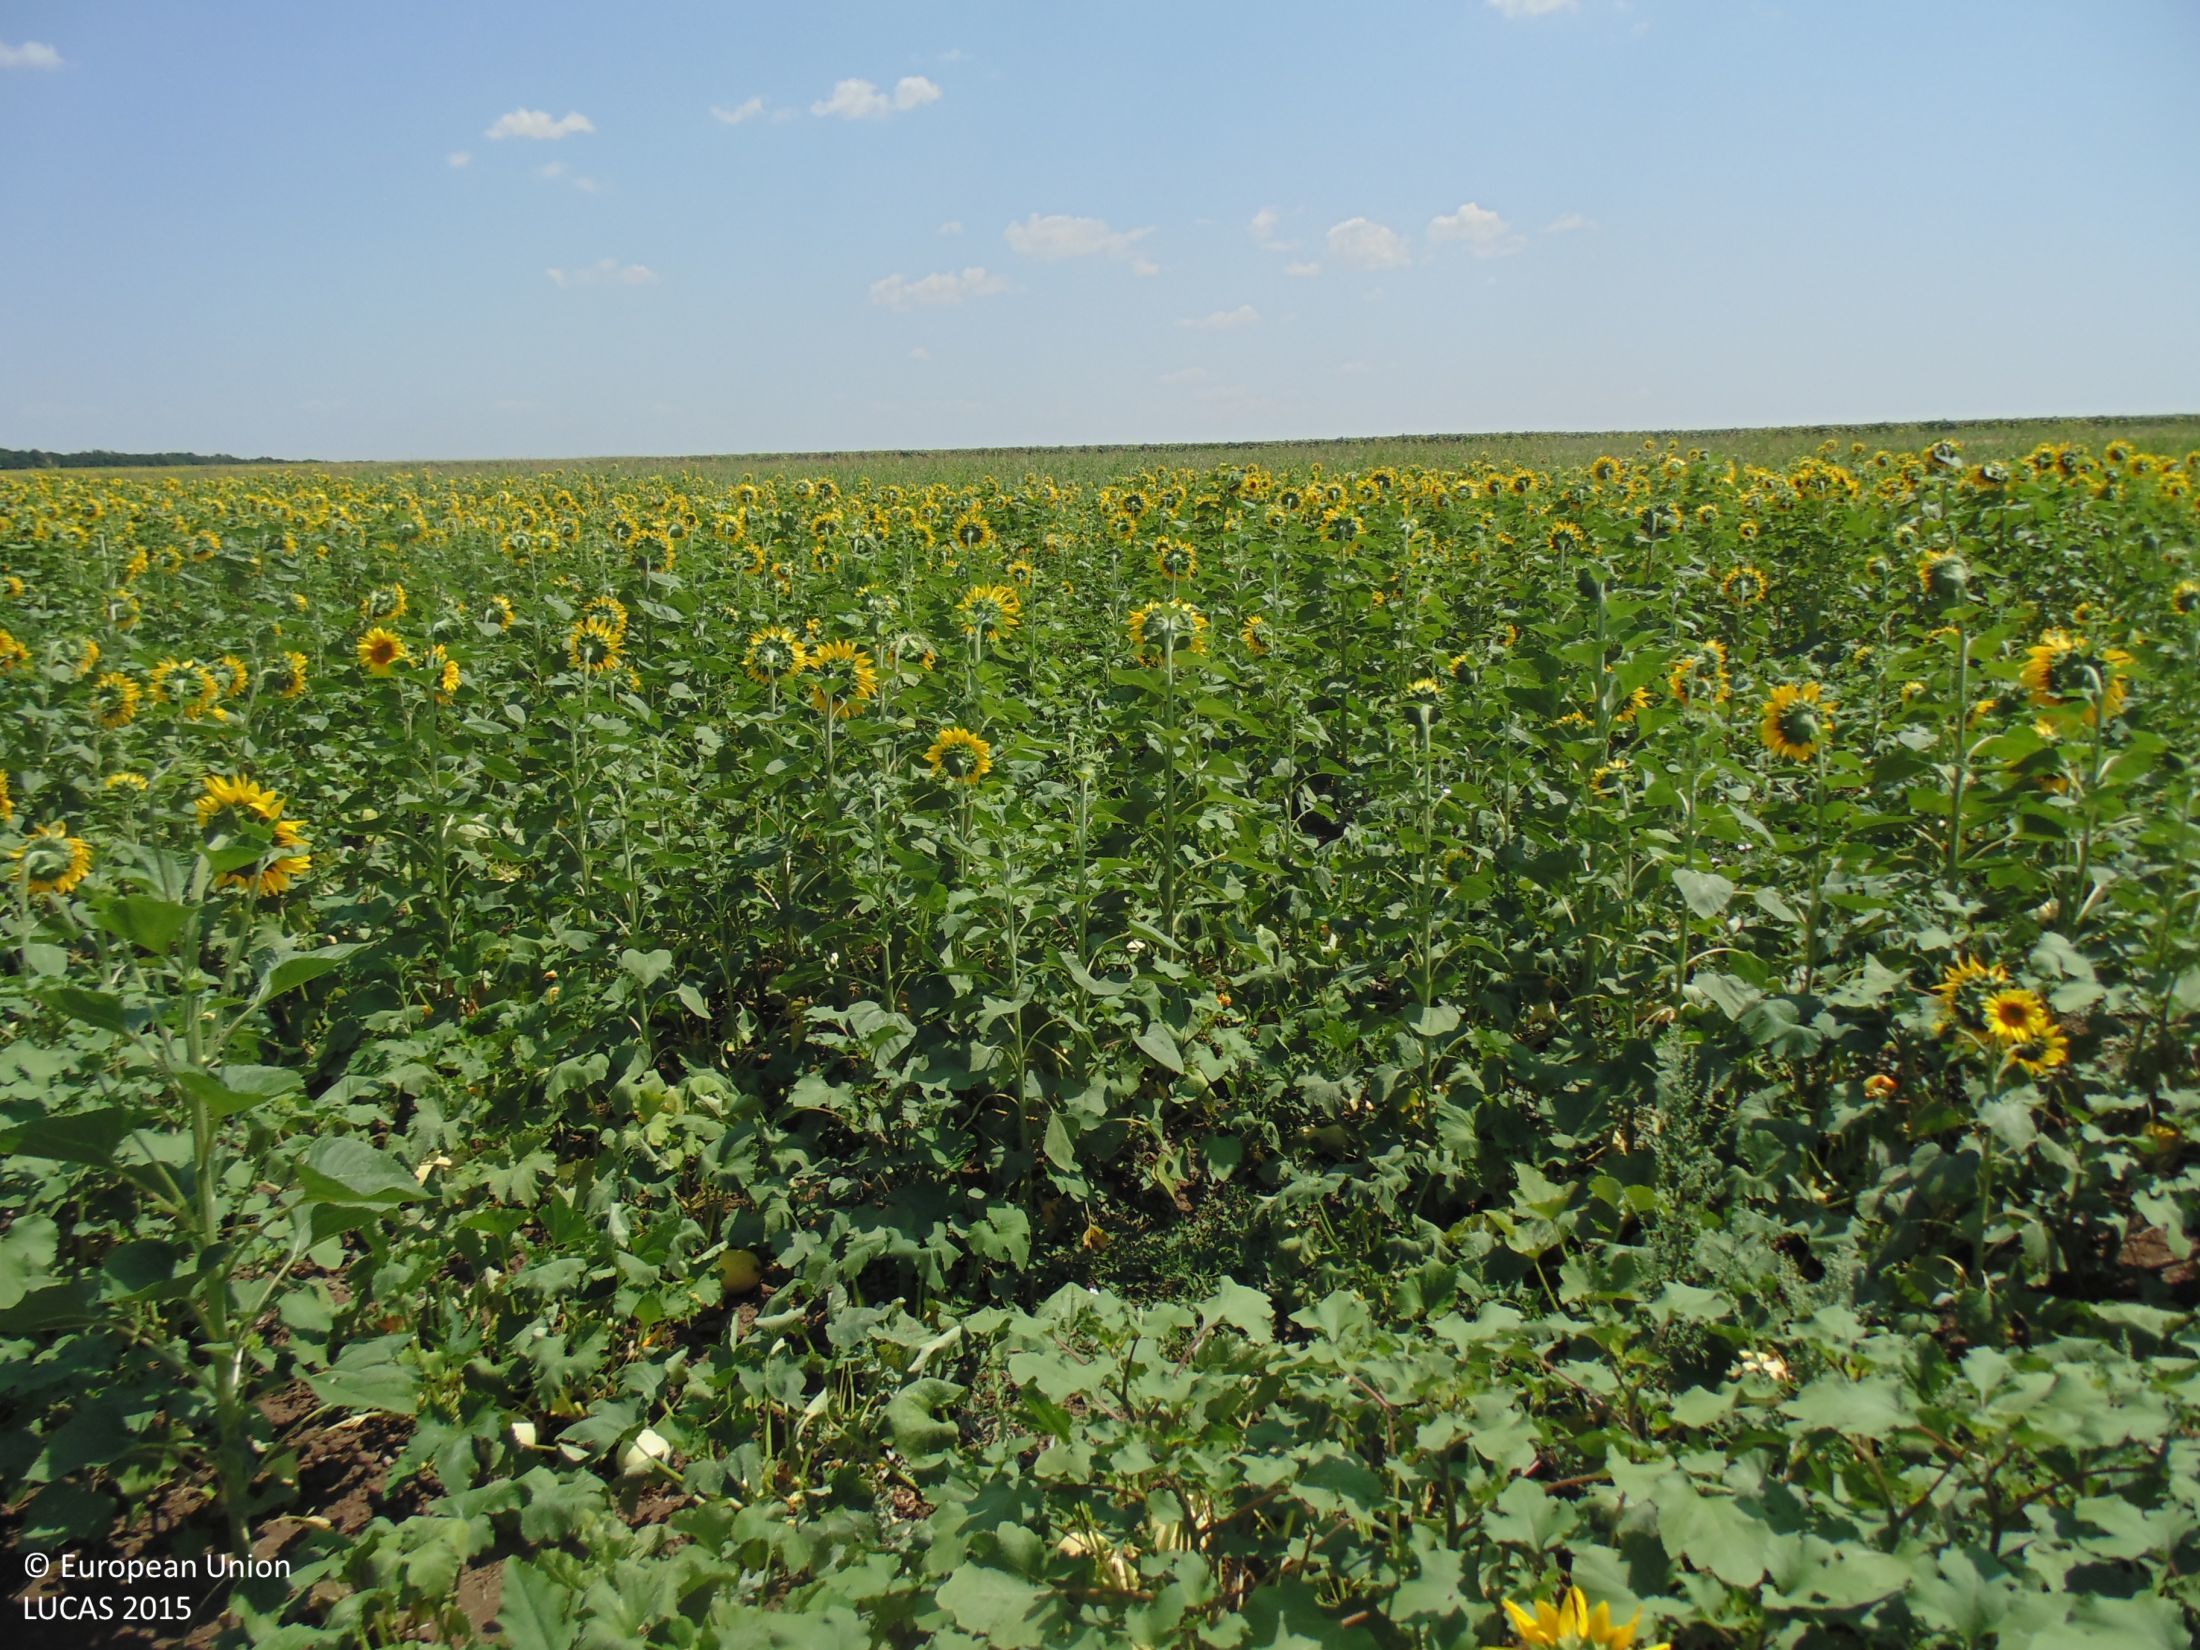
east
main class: Cropland
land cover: Other fresh vegetables
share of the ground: > 75 %
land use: Agriculture (excluding fallow land and kitchen gardens)
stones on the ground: < 10 %
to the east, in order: Other fresh vegetables; Sunflower; Common wheat; Other fresh vegetables; Sunflower
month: July
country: BG
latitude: 43.6294
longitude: 27.6751
